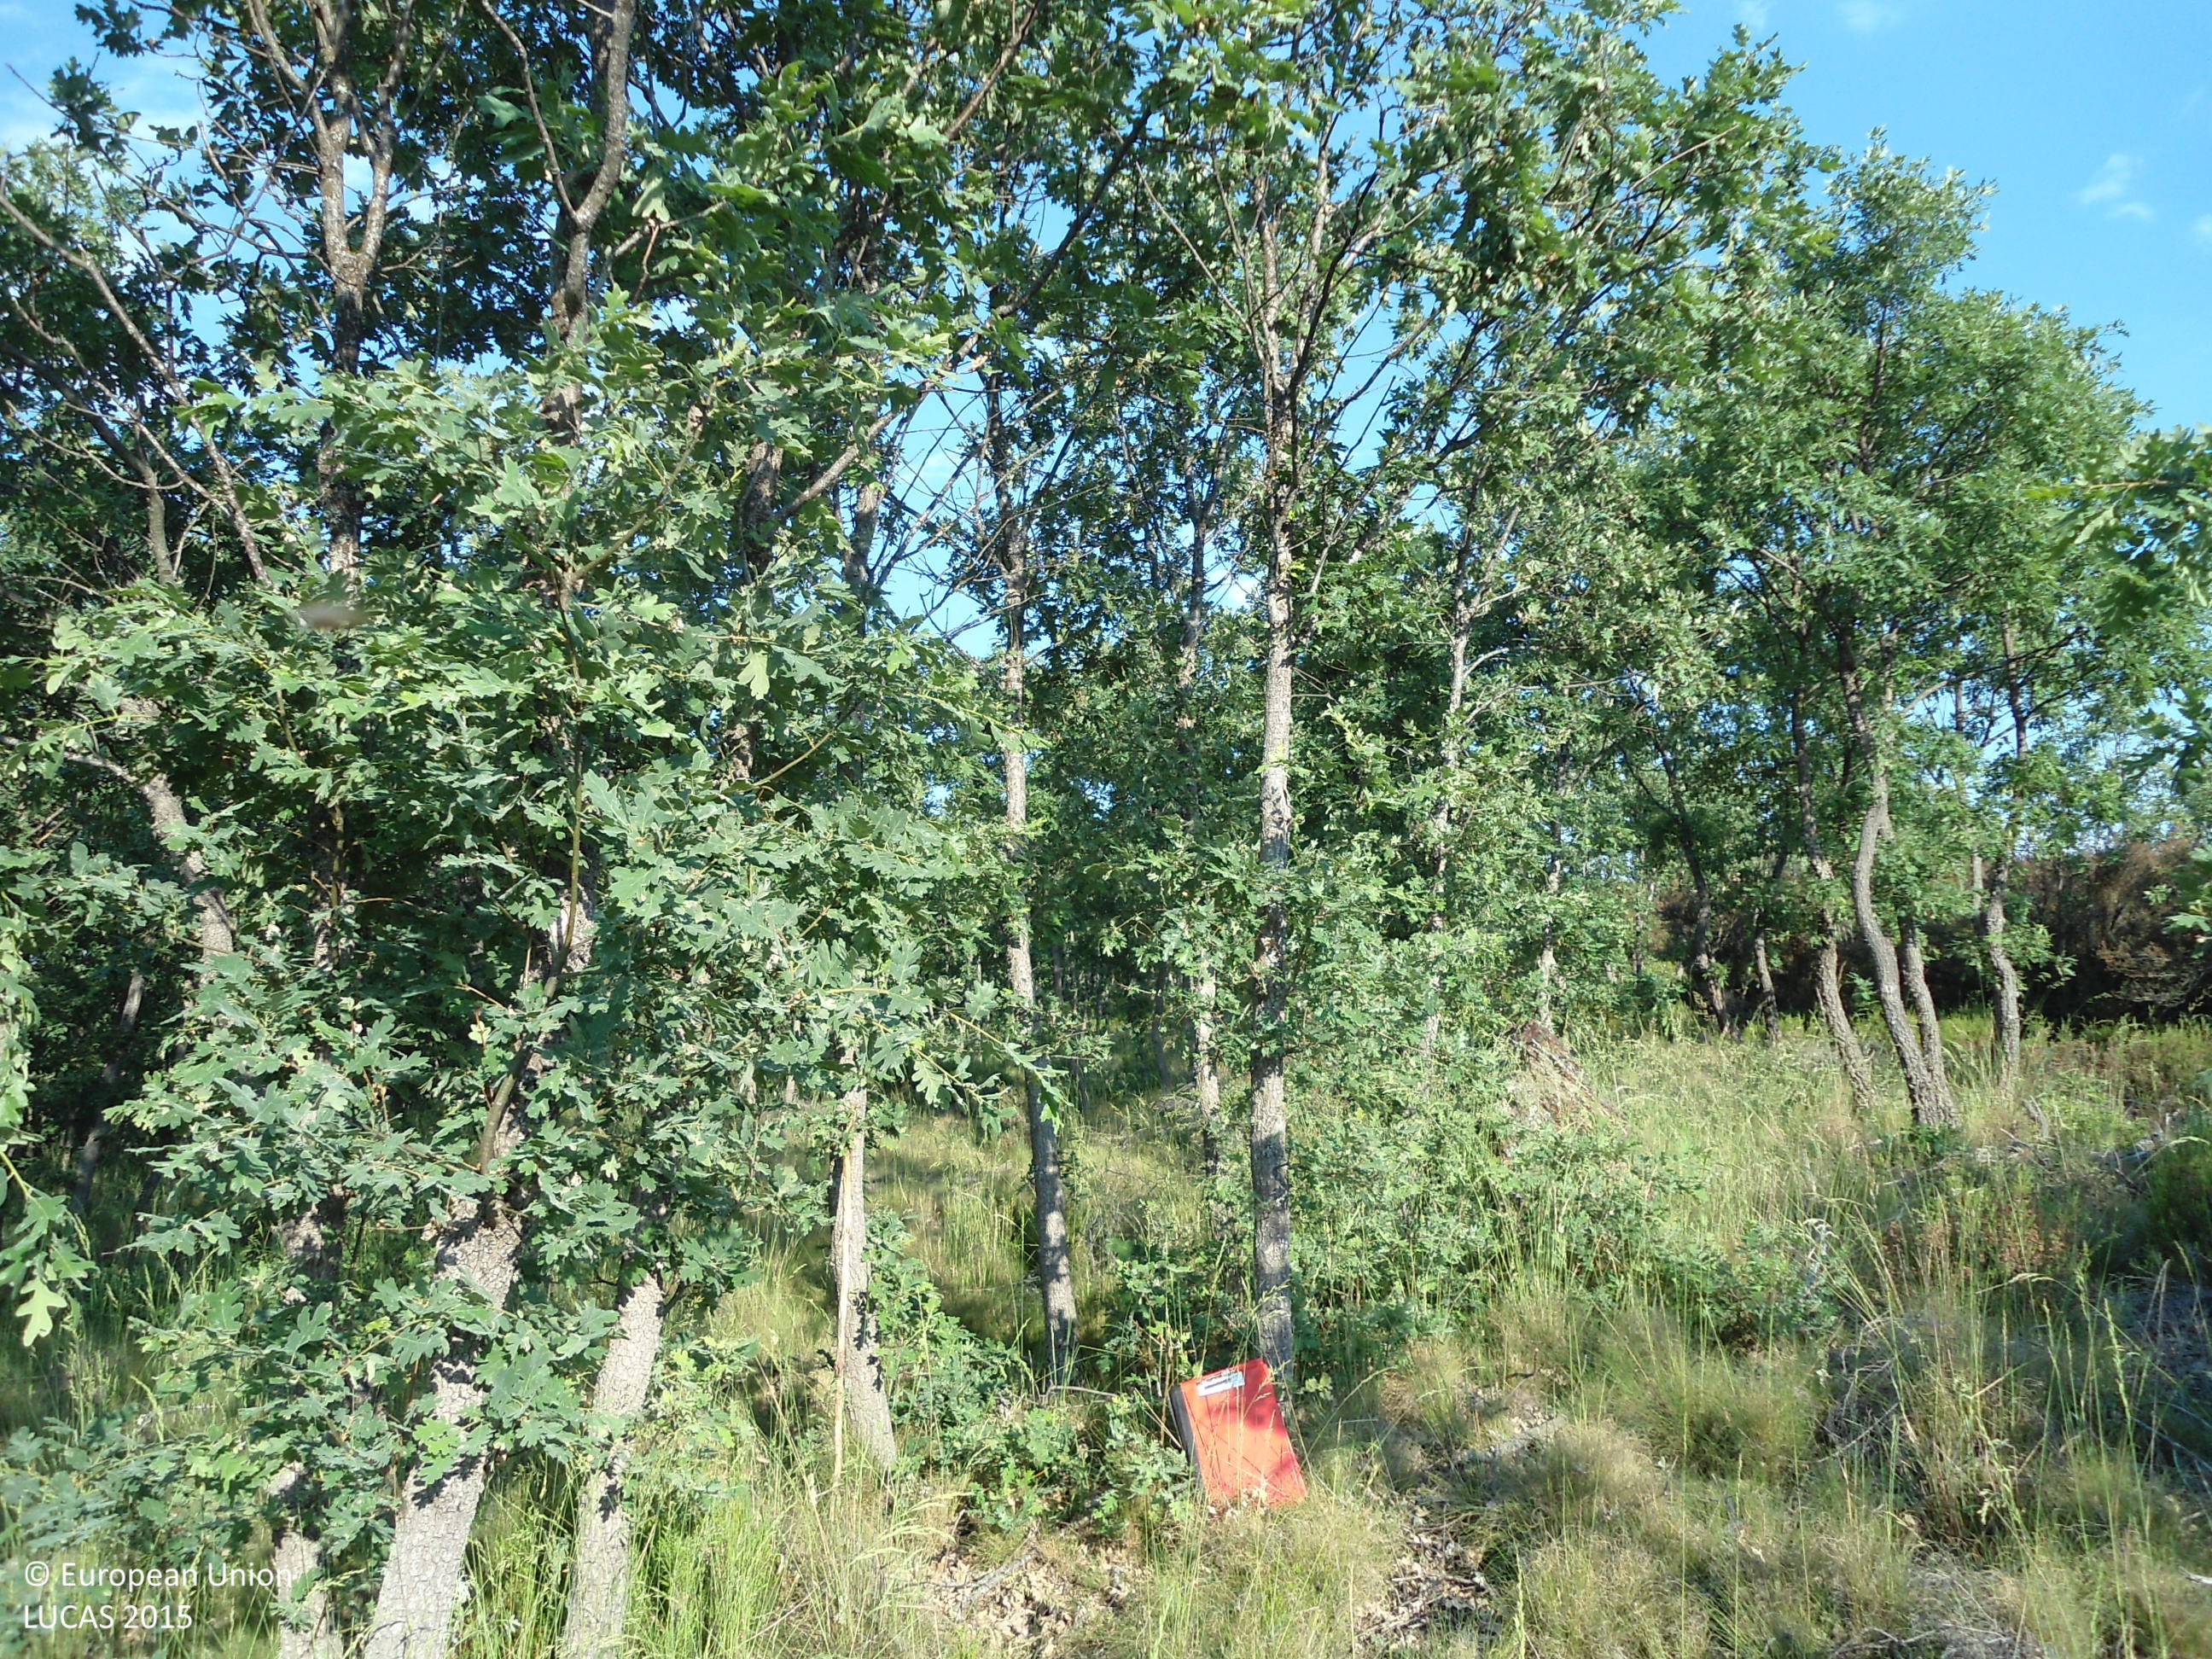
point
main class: Woodland
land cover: Broadleaved woodland
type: thermophilous deciduous forest
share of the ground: > 75 %
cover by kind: broadleaved forest trees 85 %, shrubs 10 %, herbaceous plants 5 %
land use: Forestry
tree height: > 5 m
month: June
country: ES
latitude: 42.1117
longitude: -6.4244
